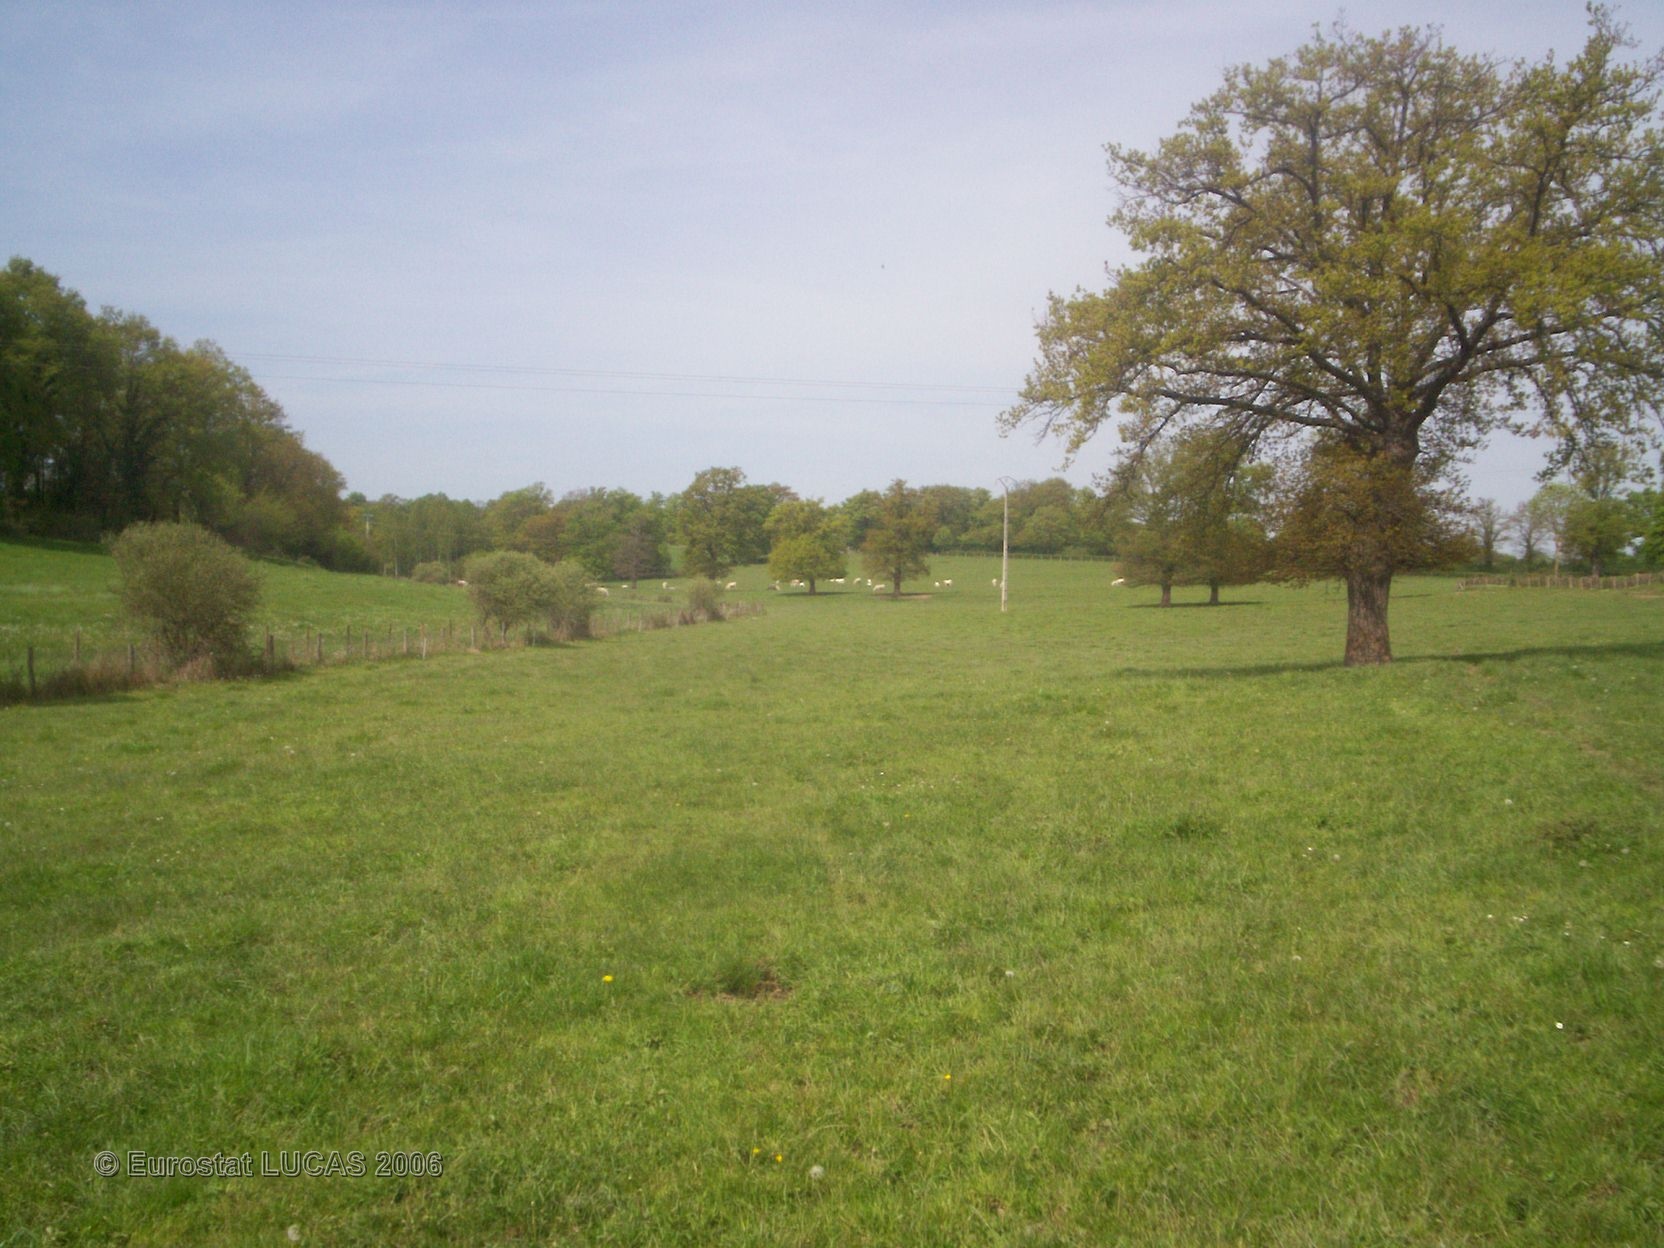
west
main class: Grassland
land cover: Grassland without tree/shrub cover
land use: Agriculture (excluding fallow land and kitchen gardens)
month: May
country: FR
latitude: 46.5439
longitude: 3.0988
